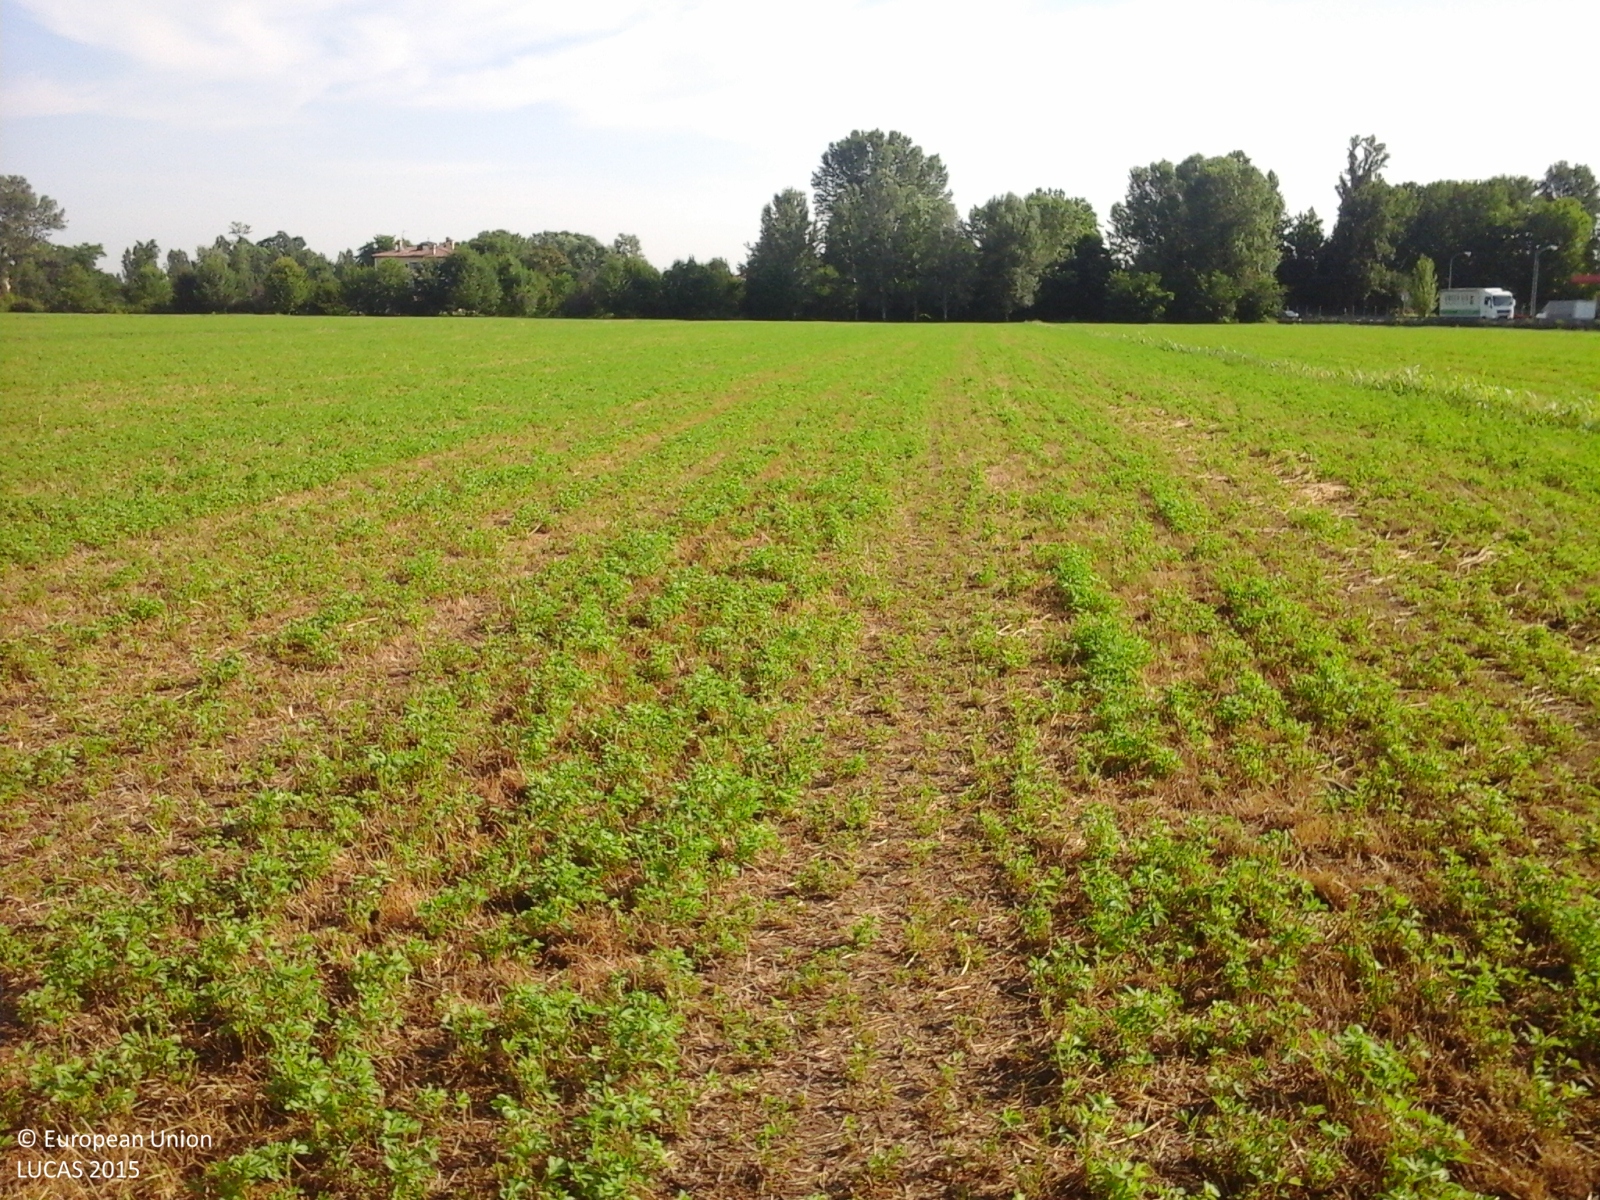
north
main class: Cropland
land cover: Lucerne
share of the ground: > 75 %
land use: Agriculture (excluding fallow land and kitchen gardens)
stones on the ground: < 10 %
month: June
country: IT
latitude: 44.5985
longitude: 10.9680
